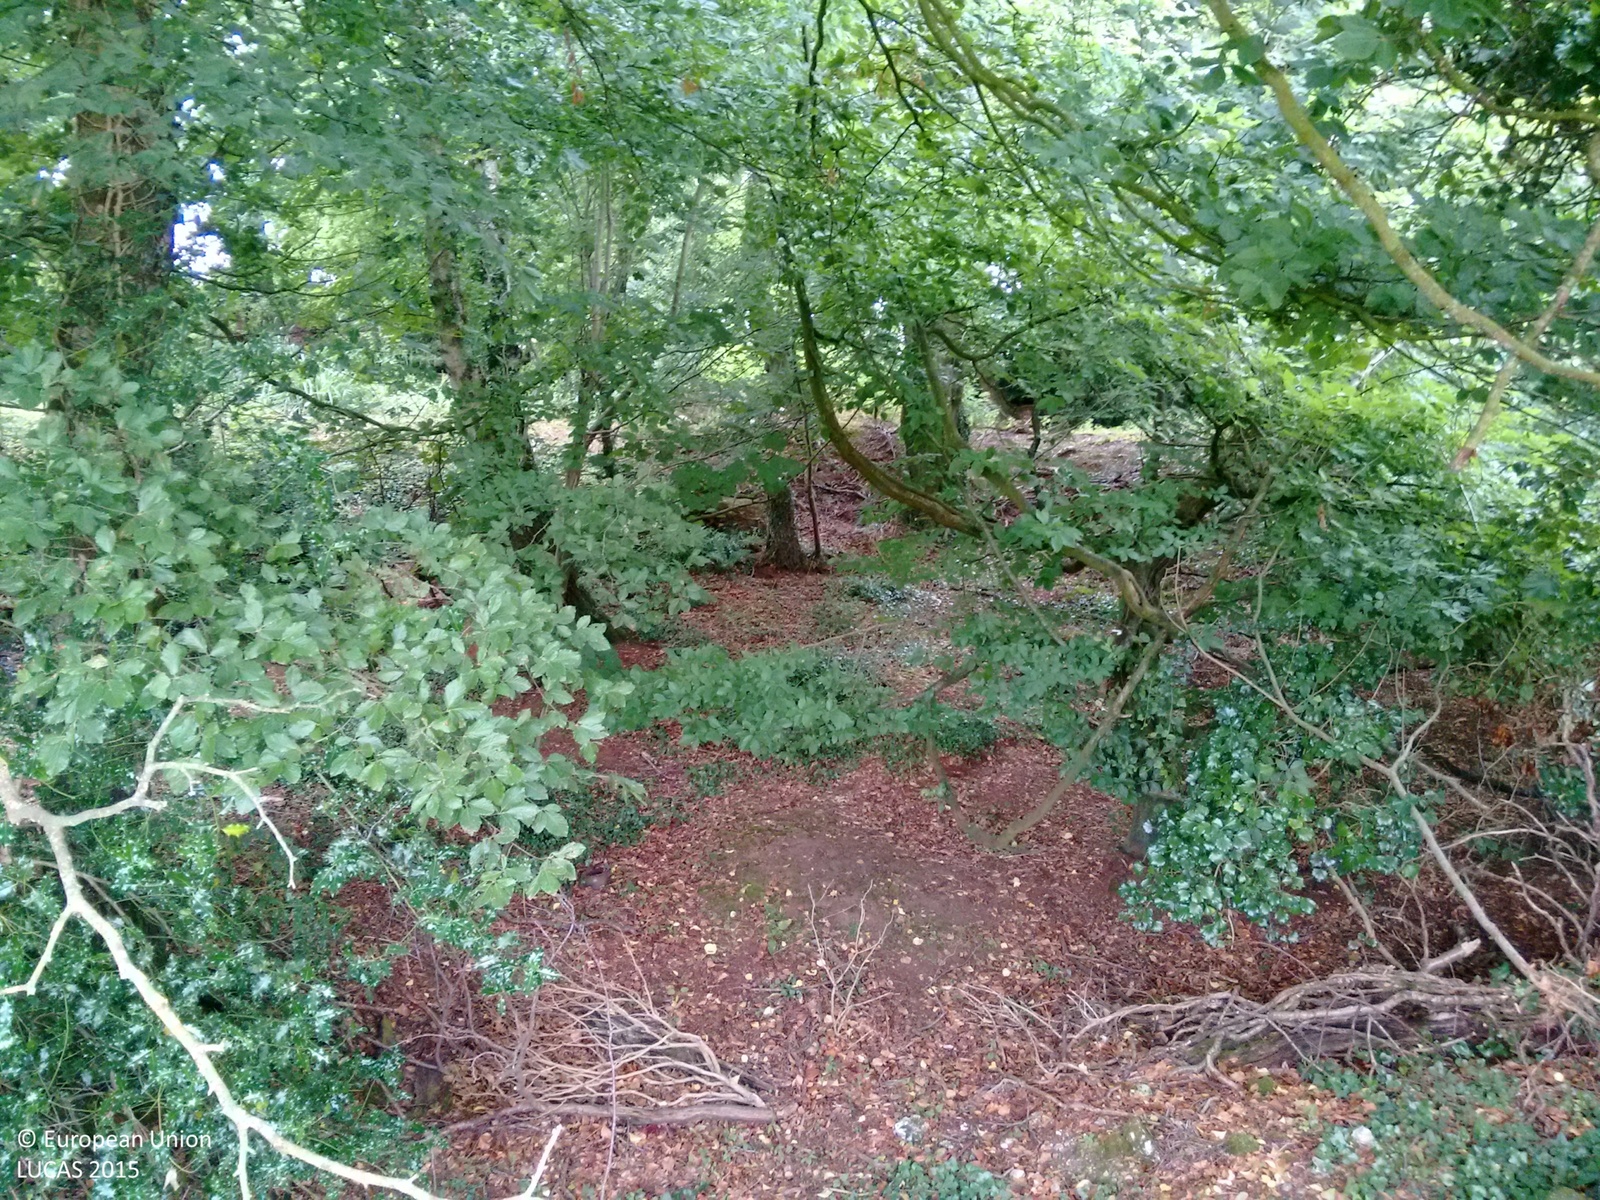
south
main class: Grassland
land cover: Grassland without tree/shrub cover
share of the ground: > 75 %
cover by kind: herbaceous plants 100 %
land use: Agriculture (excluding fallow land and kitchen gardens)
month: August
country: GB
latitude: 50.5896
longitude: -3.5747
